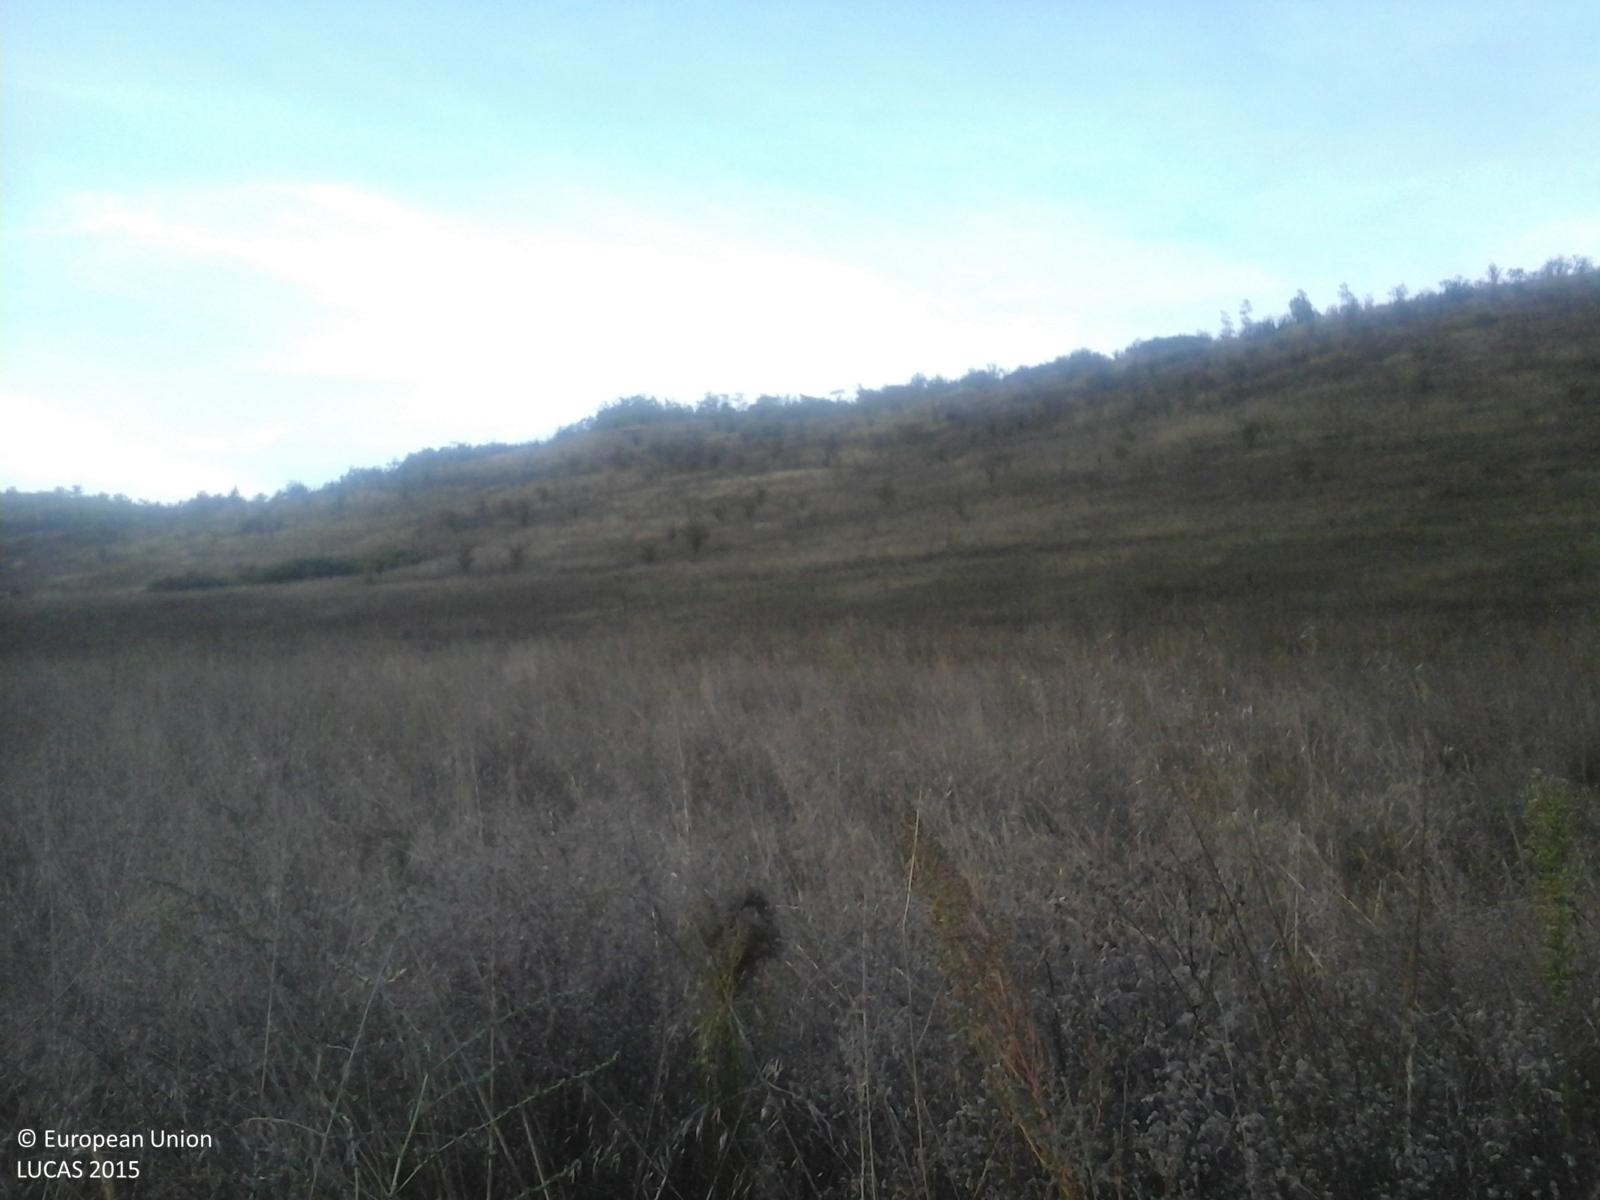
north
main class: Grassland
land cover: Spontaneously vegetated surfaces
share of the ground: > 75 %
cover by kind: herbaceous plants 100 %
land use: Fallow land
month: September
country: RO
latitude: 46.7725
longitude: 23.8926
